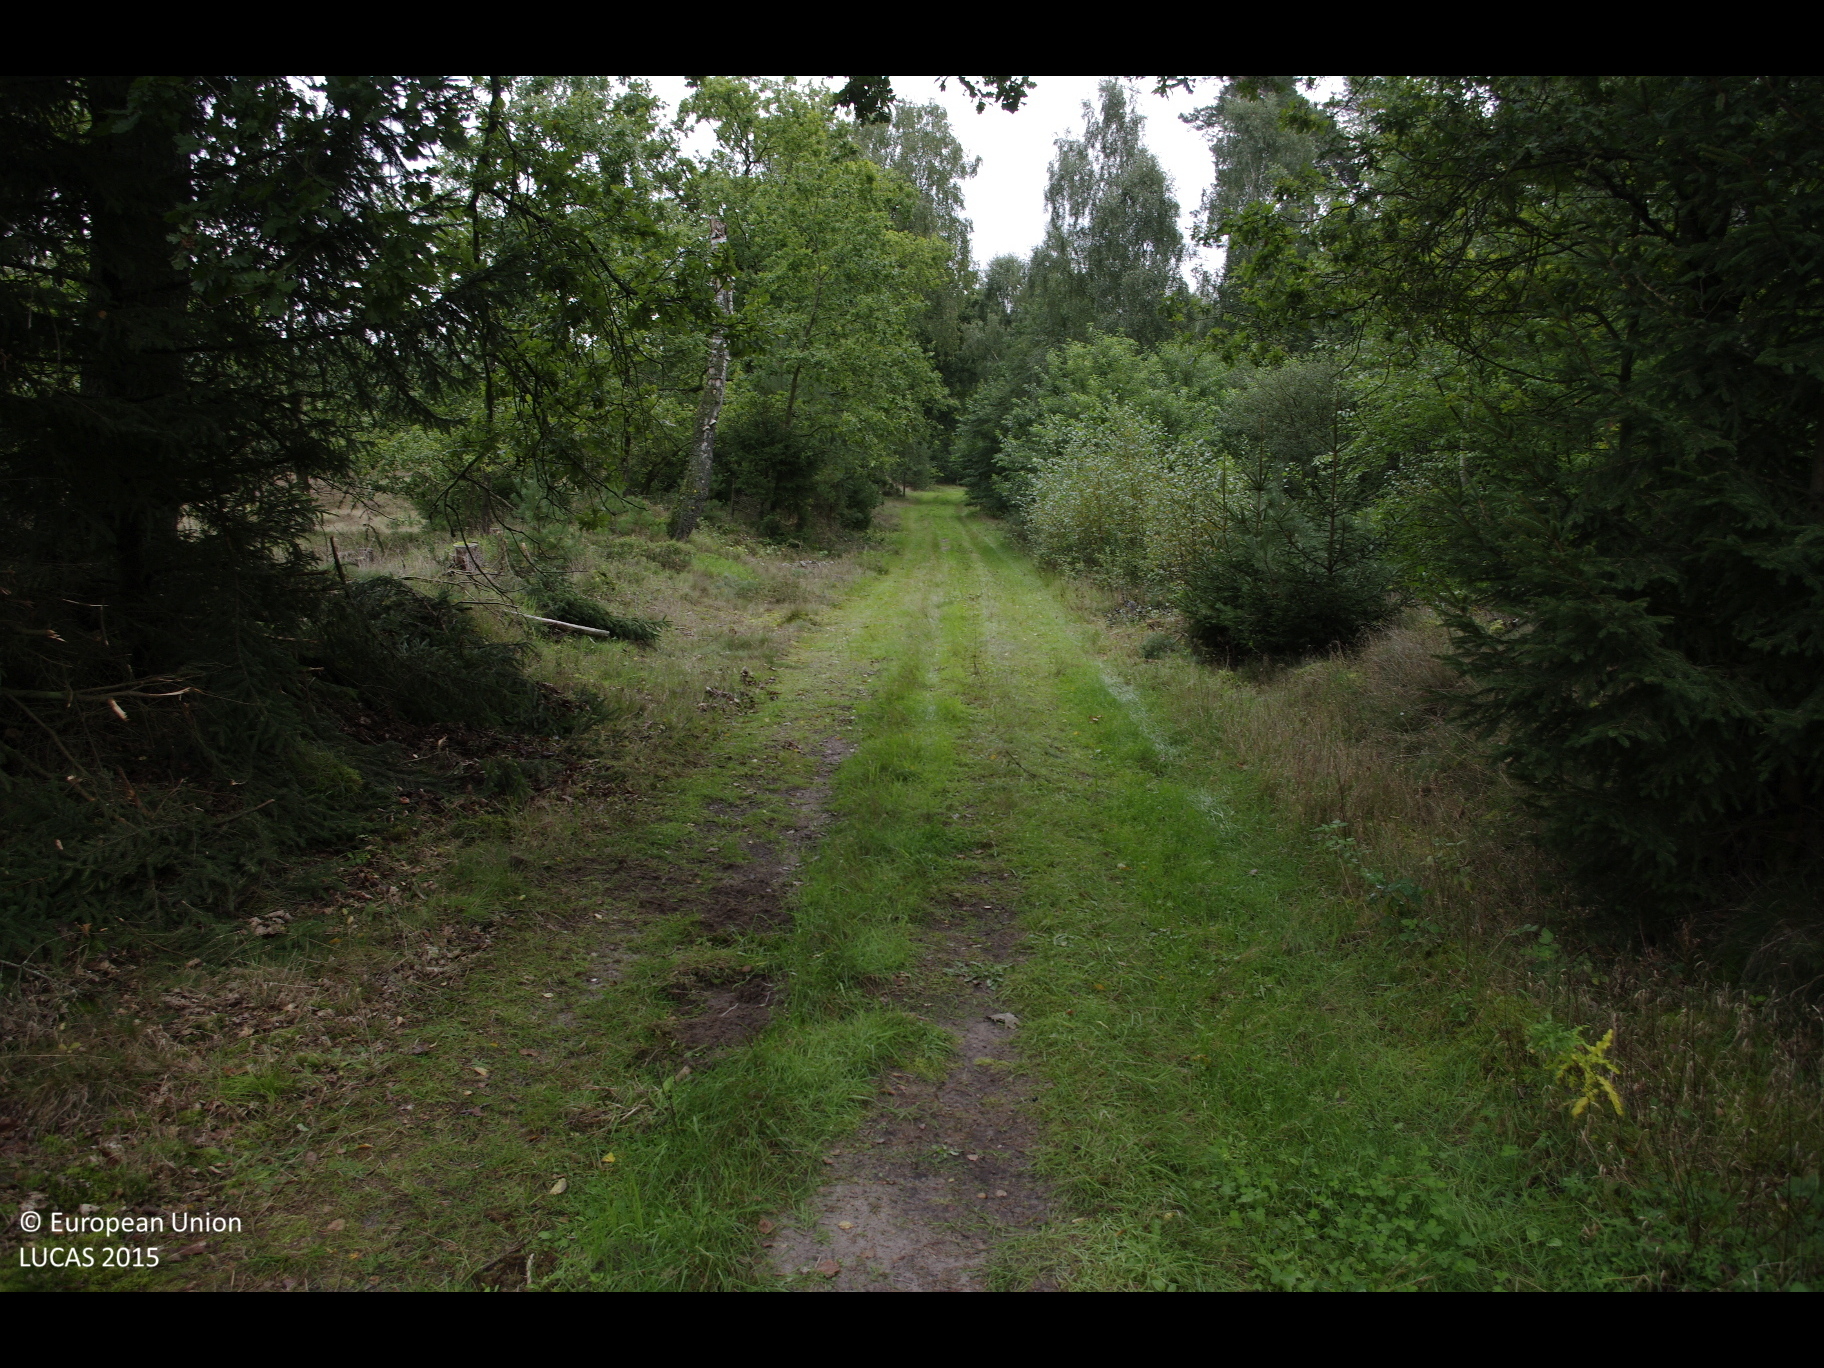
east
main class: Woodland
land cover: Pine dominated mixed woodland
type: hemiboreal forest and nemoral coniferous forest and mixed broadleaved-coniferous forest
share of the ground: > 75 %
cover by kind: coniferous forest trees 50 %, broadleaved forest trees 30 %, herbaceous plants 20 %
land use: Forestry
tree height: > 5 m
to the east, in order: Pine dominated mixed woodland; Tracks; Broadleaved woodland; Paved roads, cycling and walking lanes; Pine dominated mixed woodland; Grassland without tree/shrub cover
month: September
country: DE
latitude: 53.0964
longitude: 9.9254
